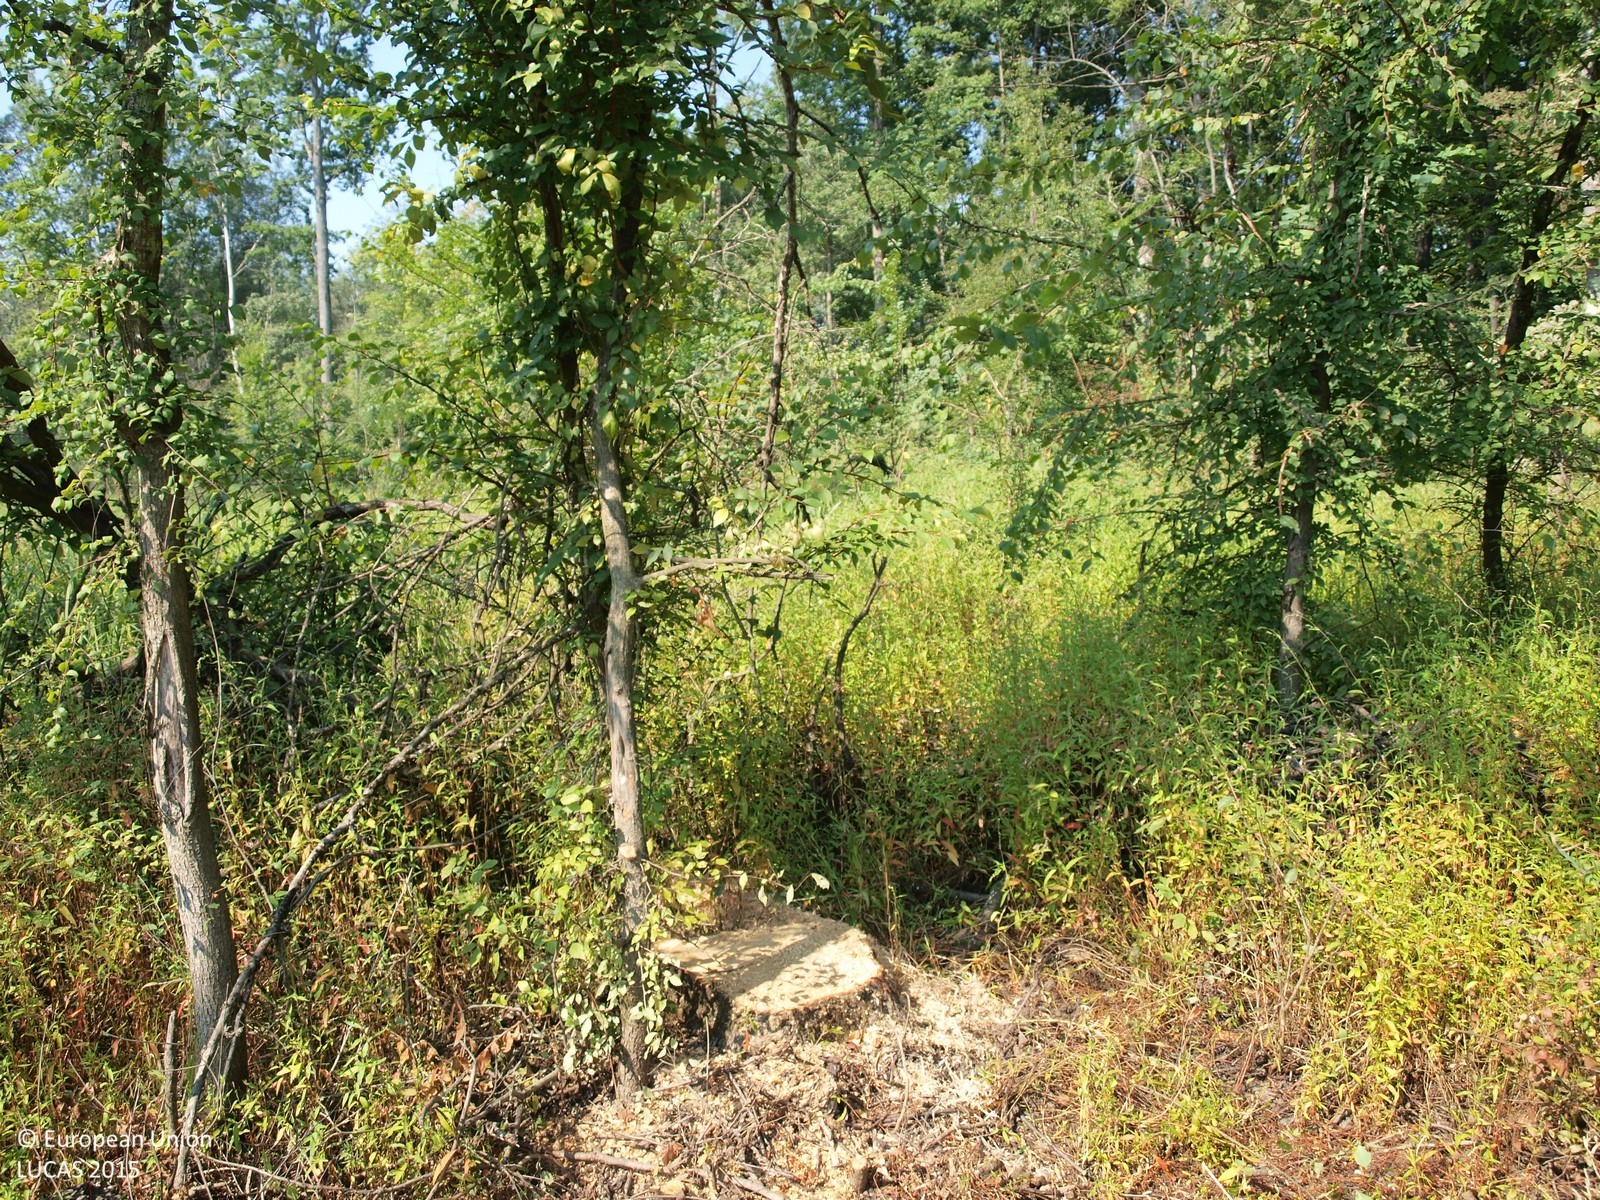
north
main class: Woodland
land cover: Broadleaved woodland
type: floodplain forest
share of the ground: > 75 %
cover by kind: broadleaved forest trees 100 %
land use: Forestry
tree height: > 5 m
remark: Clear cut
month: August
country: HR
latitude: 45.5950
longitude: 16.4721
